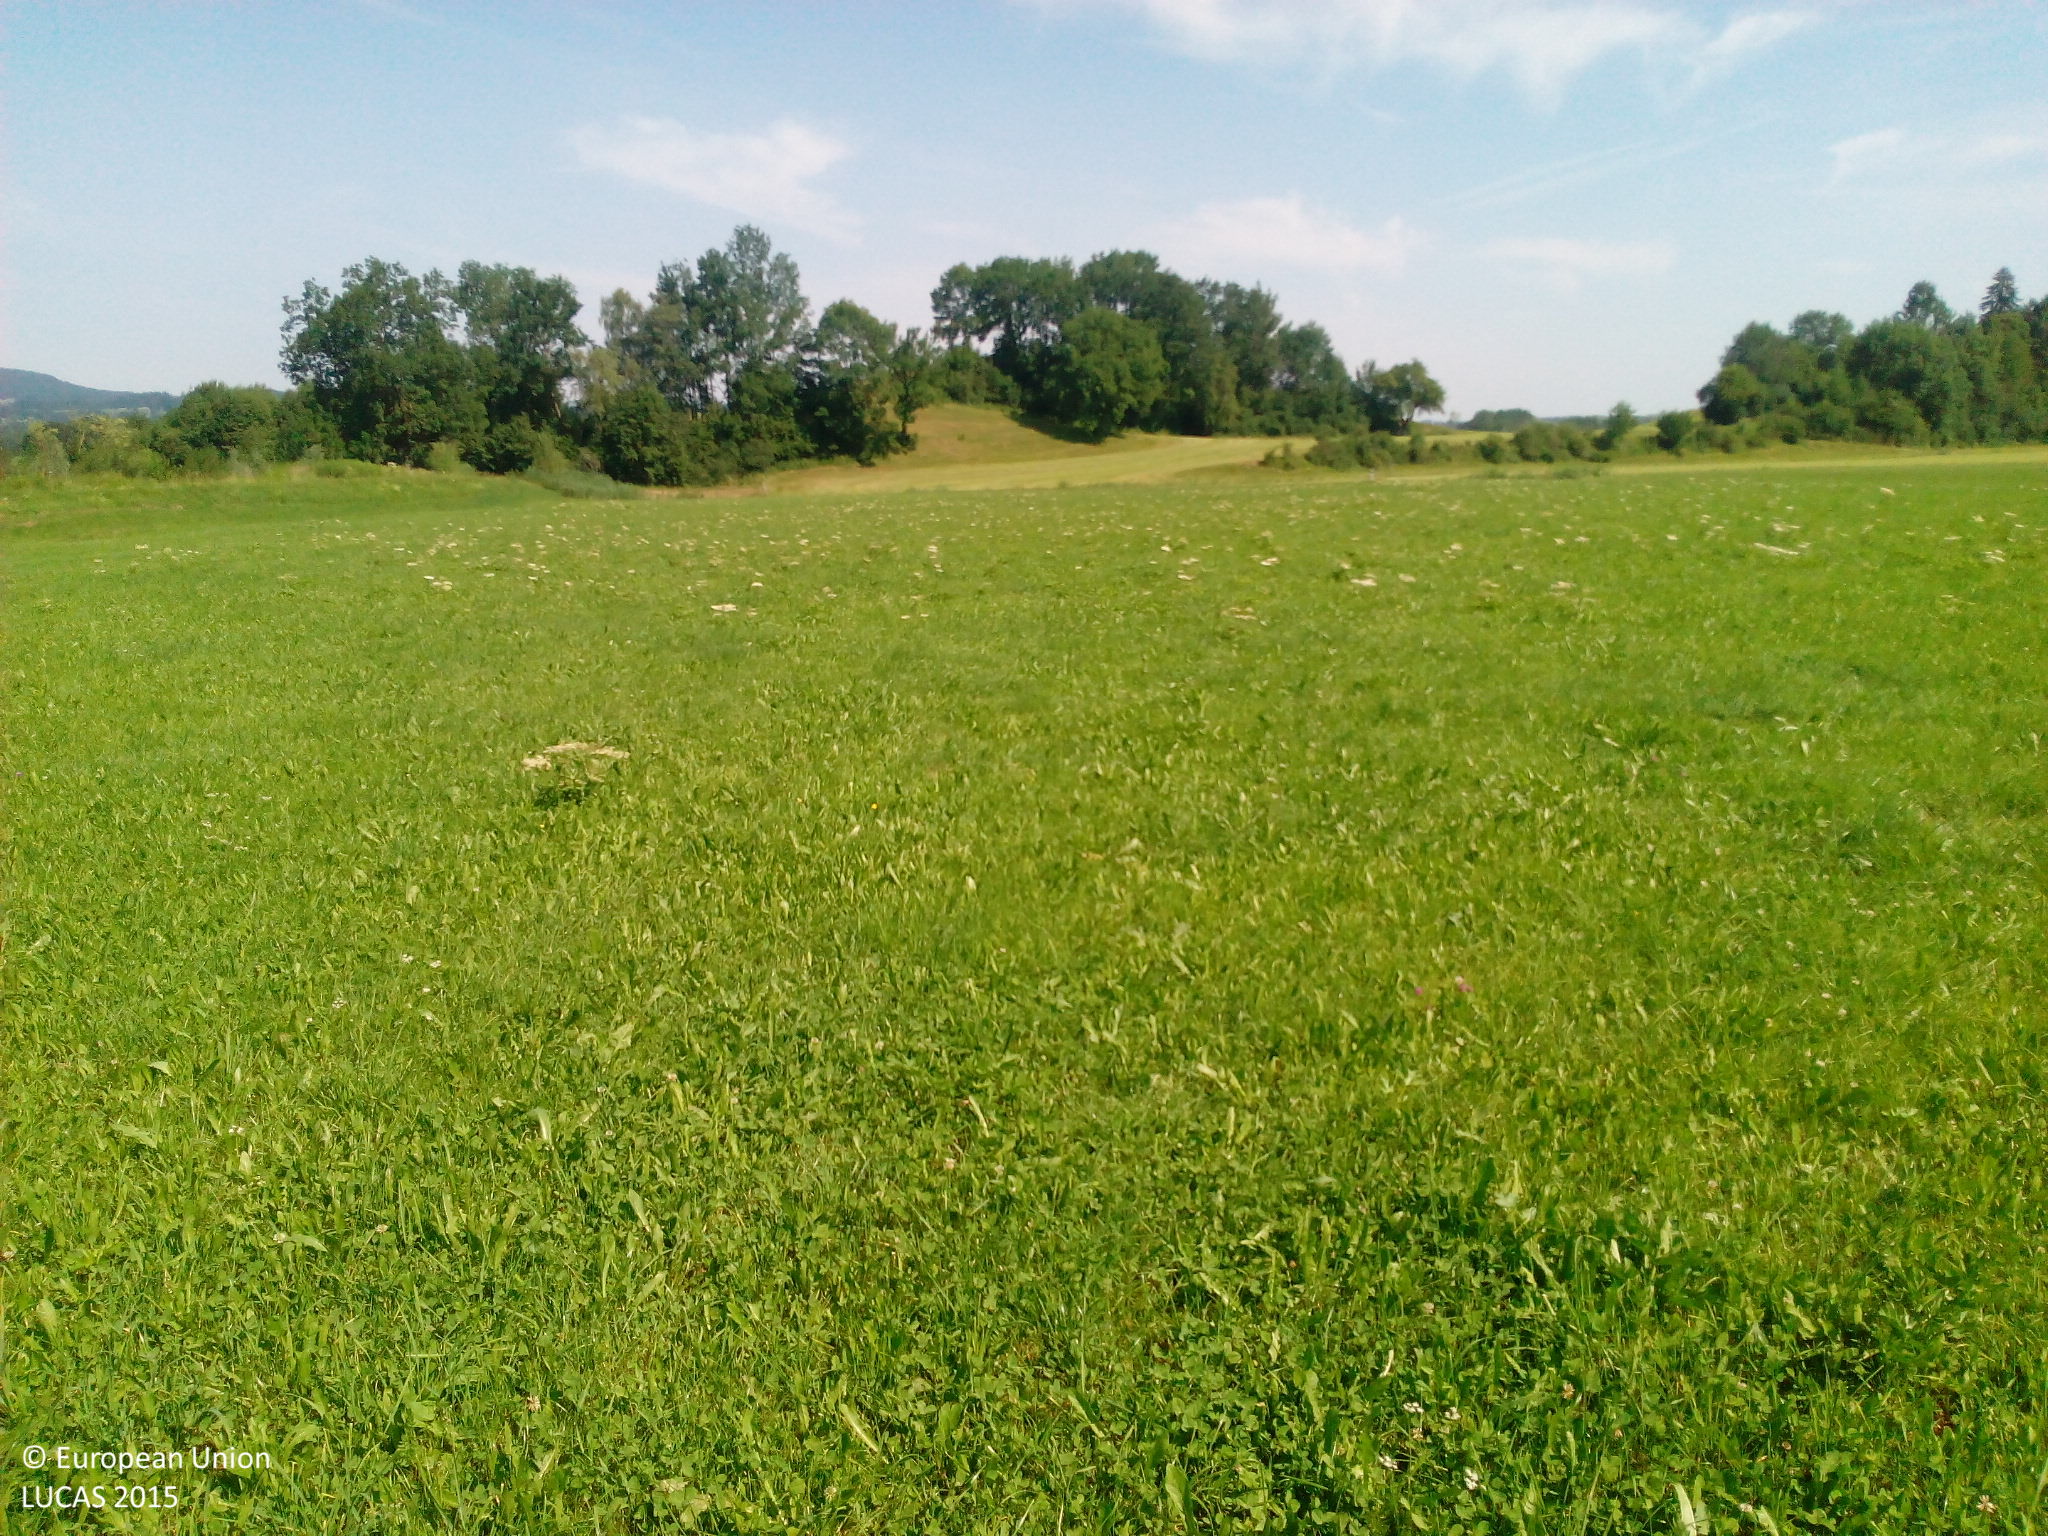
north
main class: Grassland
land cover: Grassland without tree/shrub cover
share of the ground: > 75 %
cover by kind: herbaceous plants 100 %
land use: Agriculture (excluding fallow land and kitchen gardens)
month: July
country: DE
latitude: 47.5753
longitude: 10.2524
